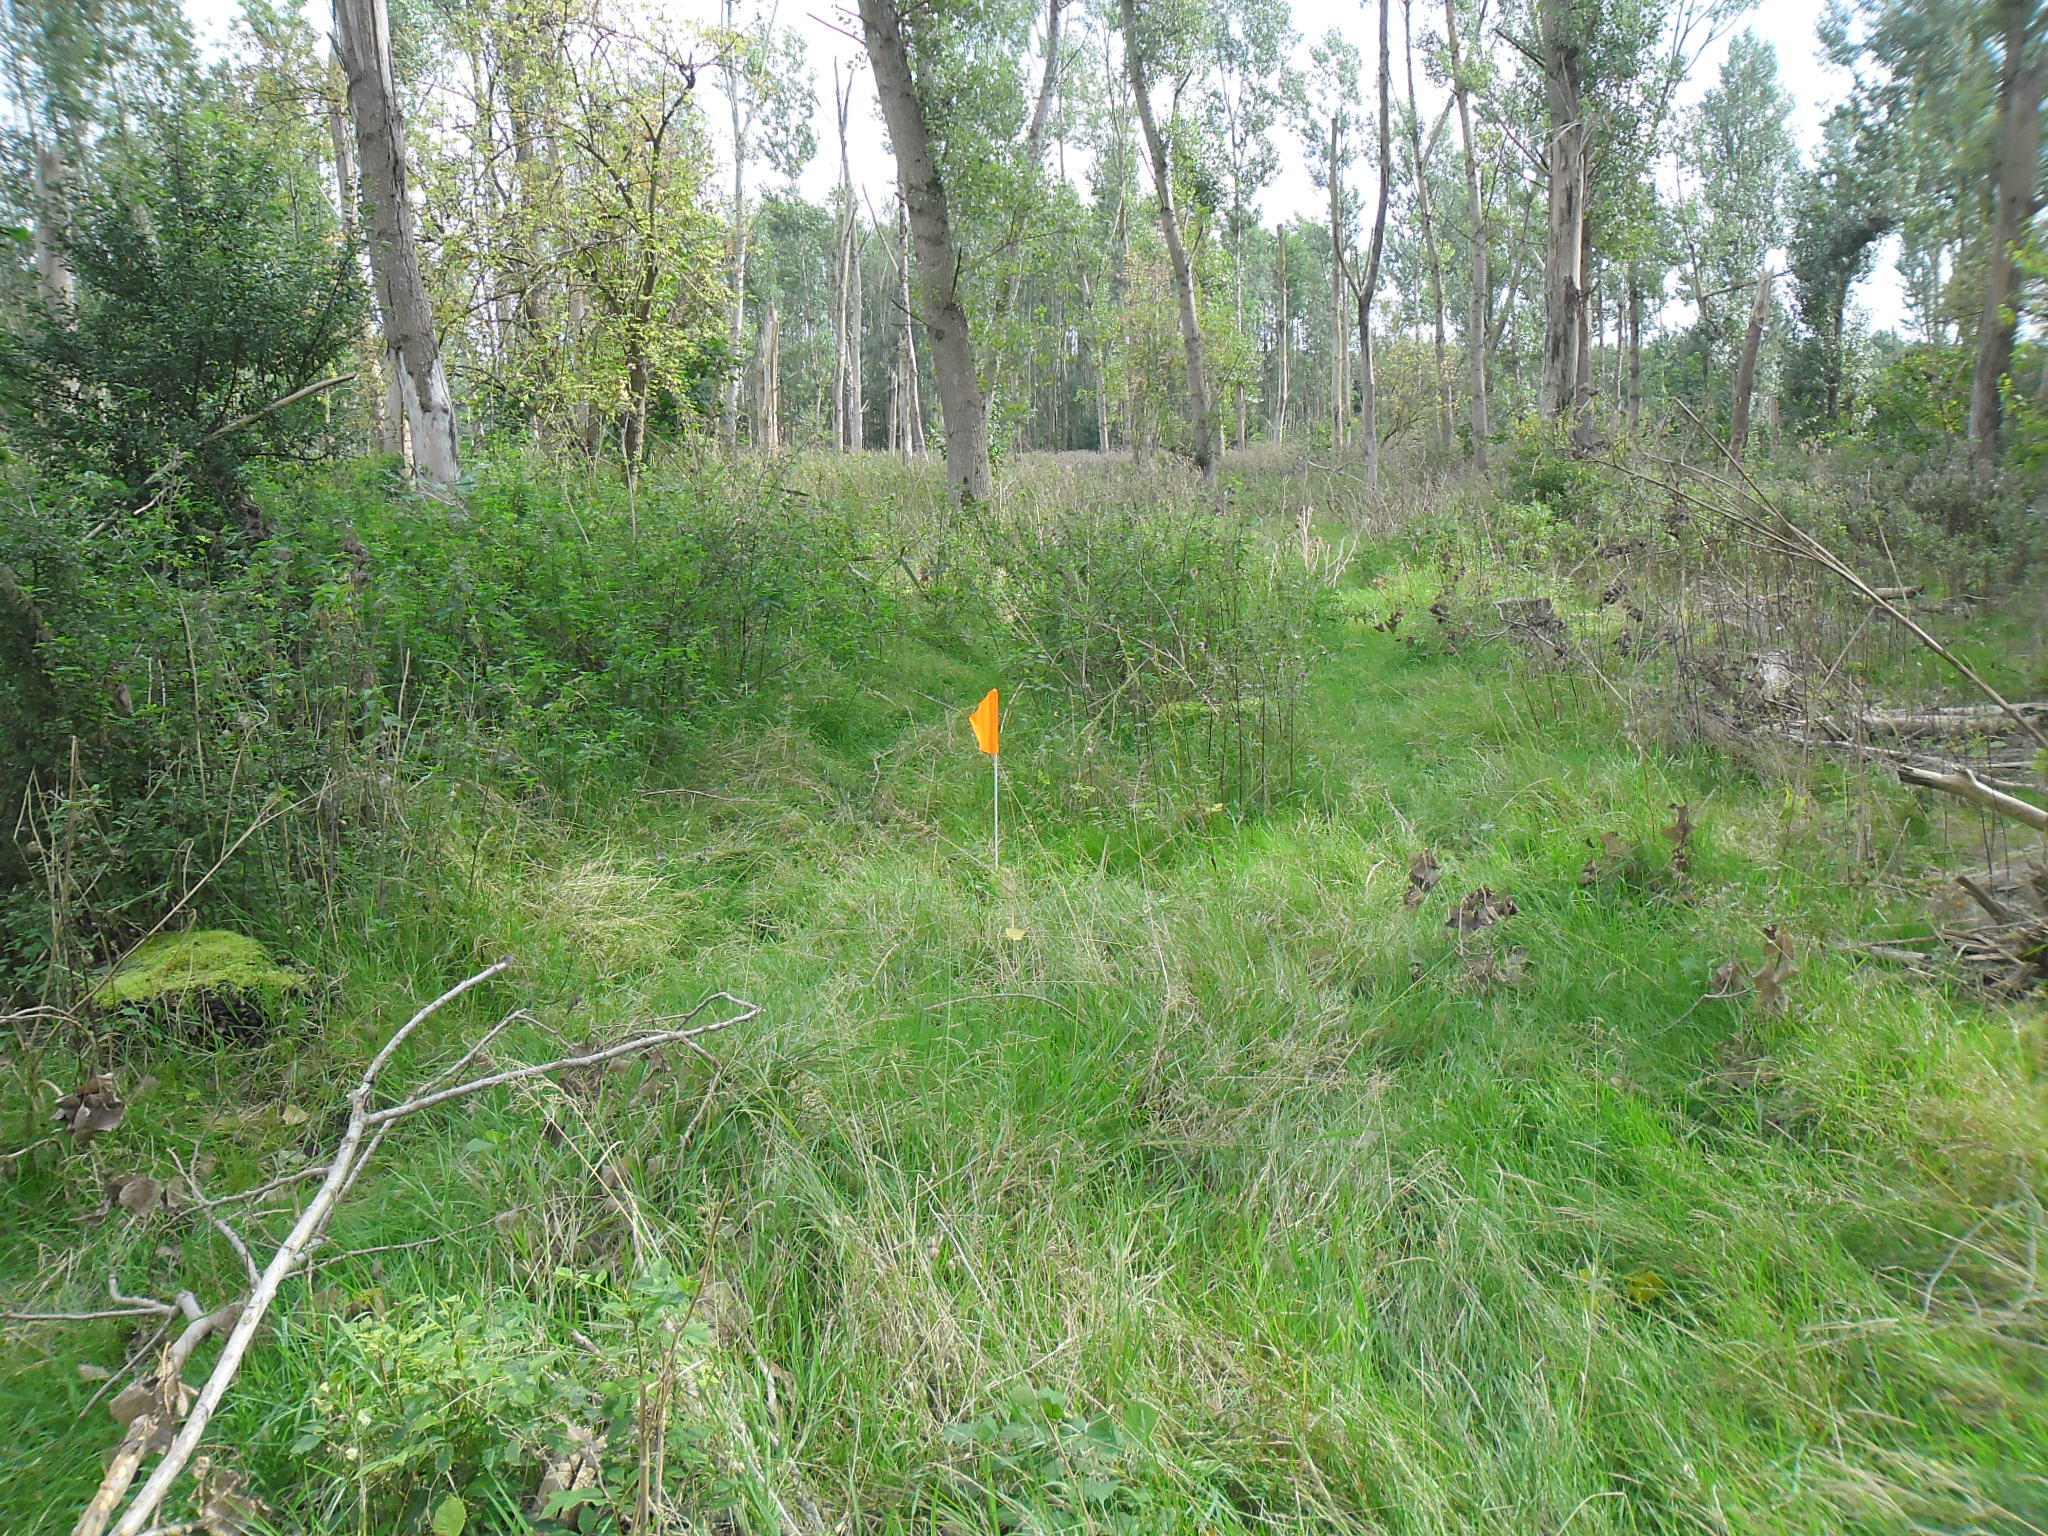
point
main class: Woodland
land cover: Broadleaved woodland
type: non-riverine alder, birch or aspen forest
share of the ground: > 75 %
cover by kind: broadleaved forest trees 80 %, herbaceous plants 20 %
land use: Forestry
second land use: Amenities, museums, leisure
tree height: > 5 m
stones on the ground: < 10 %
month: September
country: NL
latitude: 52.2910
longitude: 5.4680
